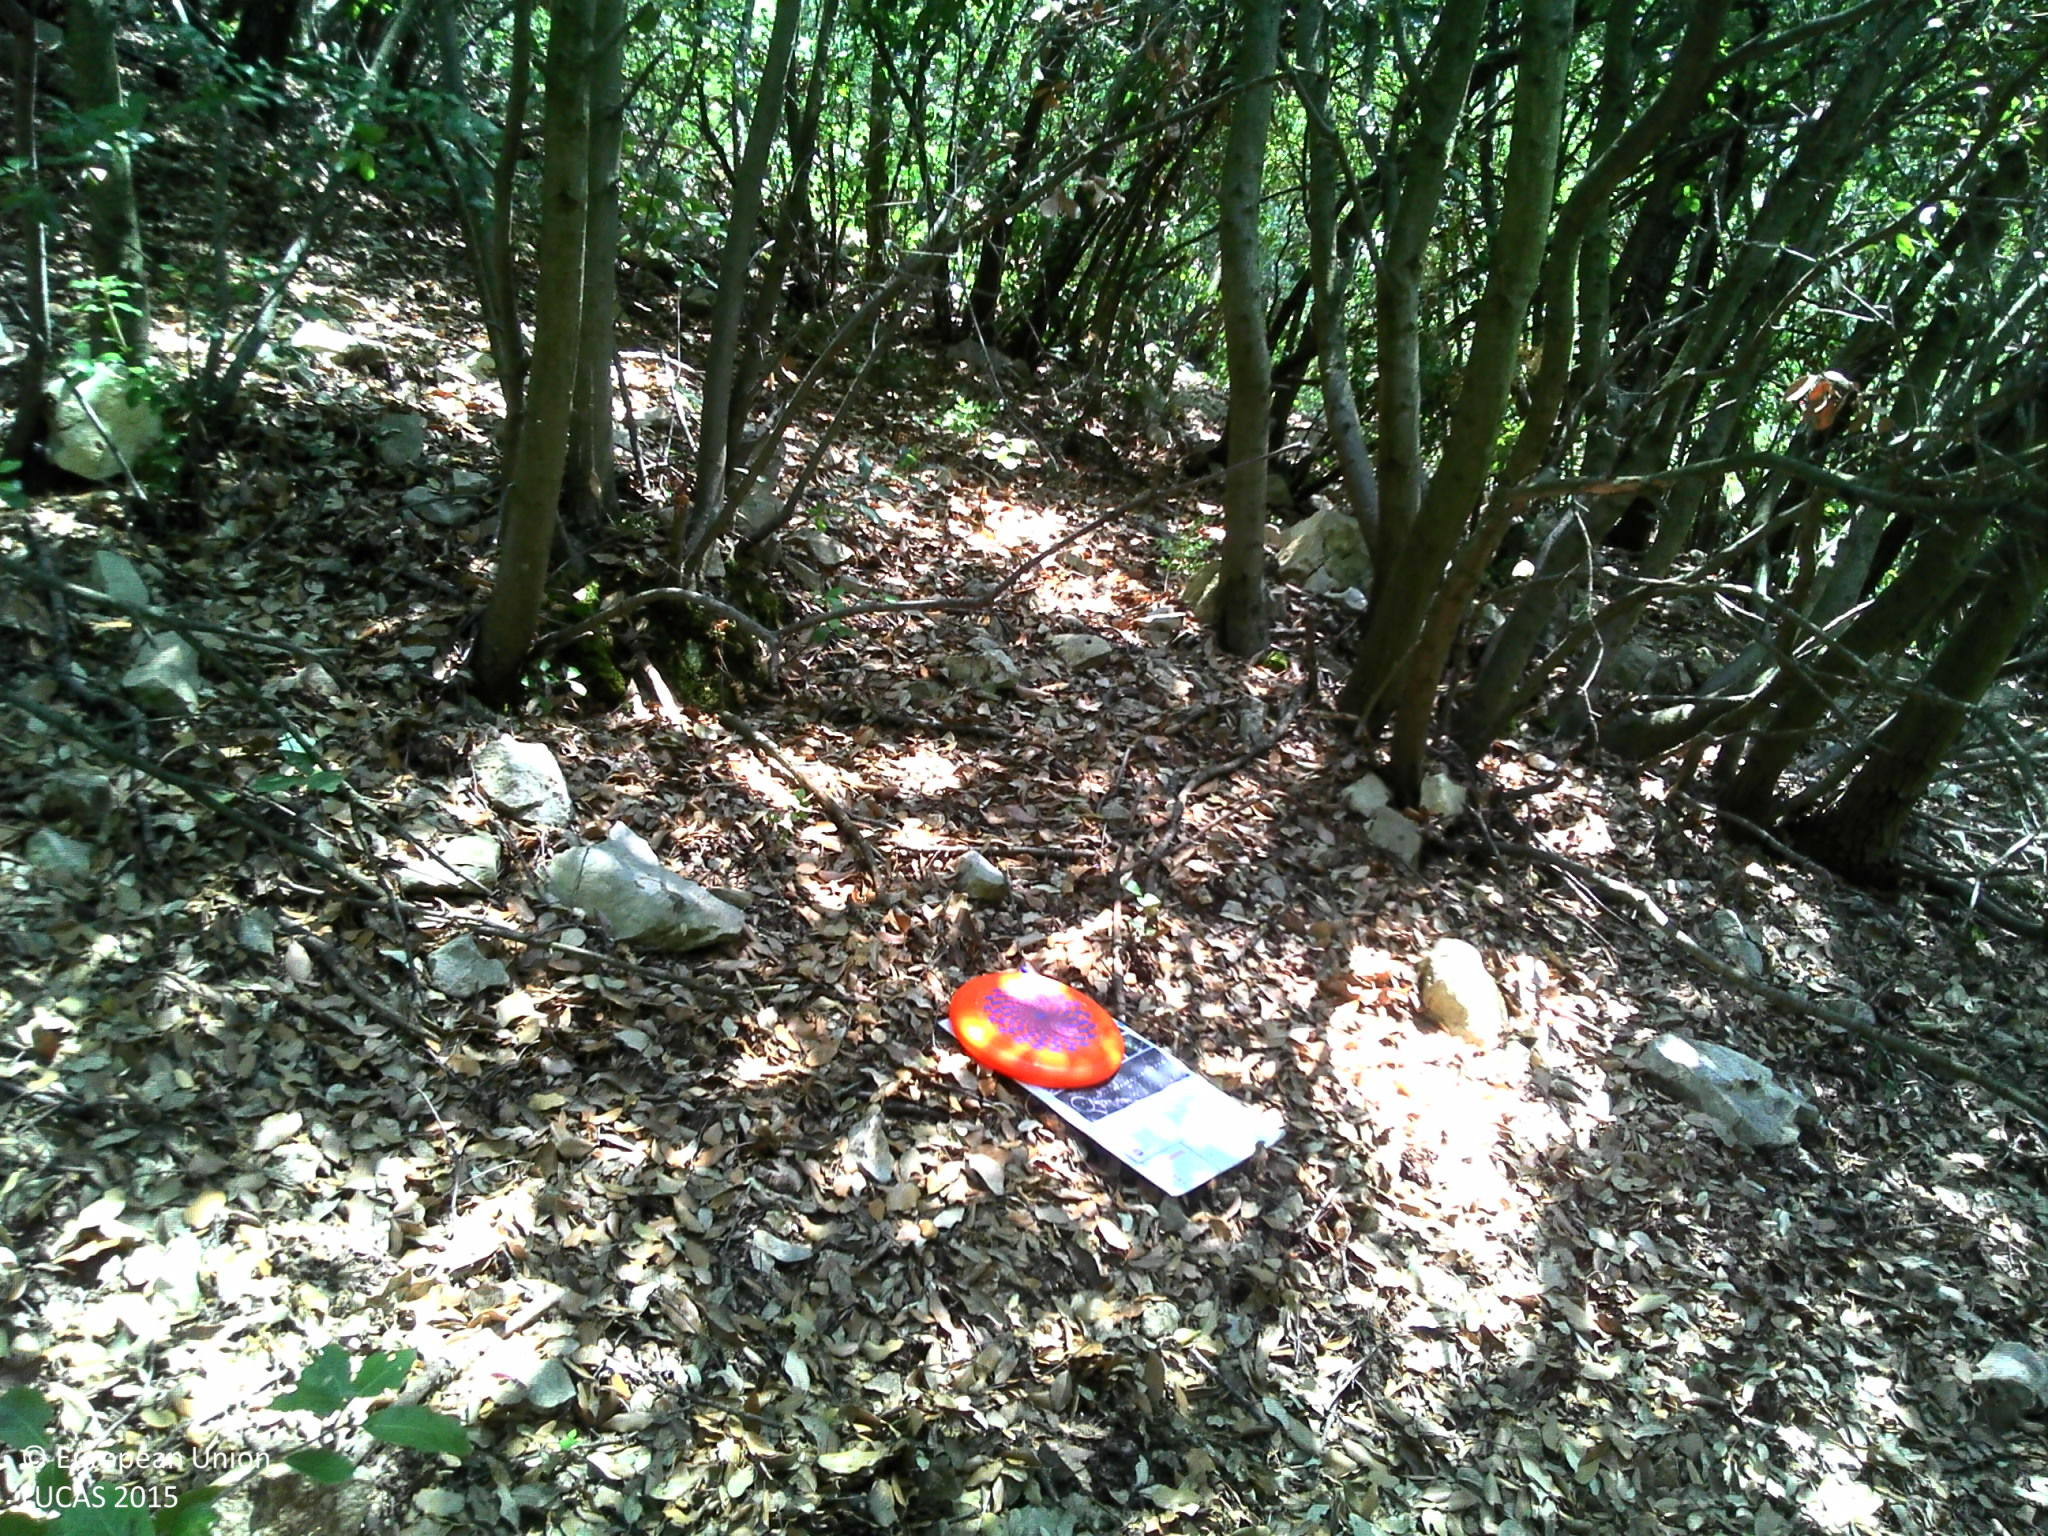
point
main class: Woodland
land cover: Broadleaved woodland
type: broadleaved evergreen forest
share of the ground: > 75 %
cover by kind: broadleaved forest trees 70 %, shrubs 15 %, coniferous forest trees 10 %, unconsolidated bare surface 5 %
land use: Semi-natural and natural areas not in use
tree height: > 5 m
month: July
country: FR
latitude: 44.0612
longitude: 5.2519
